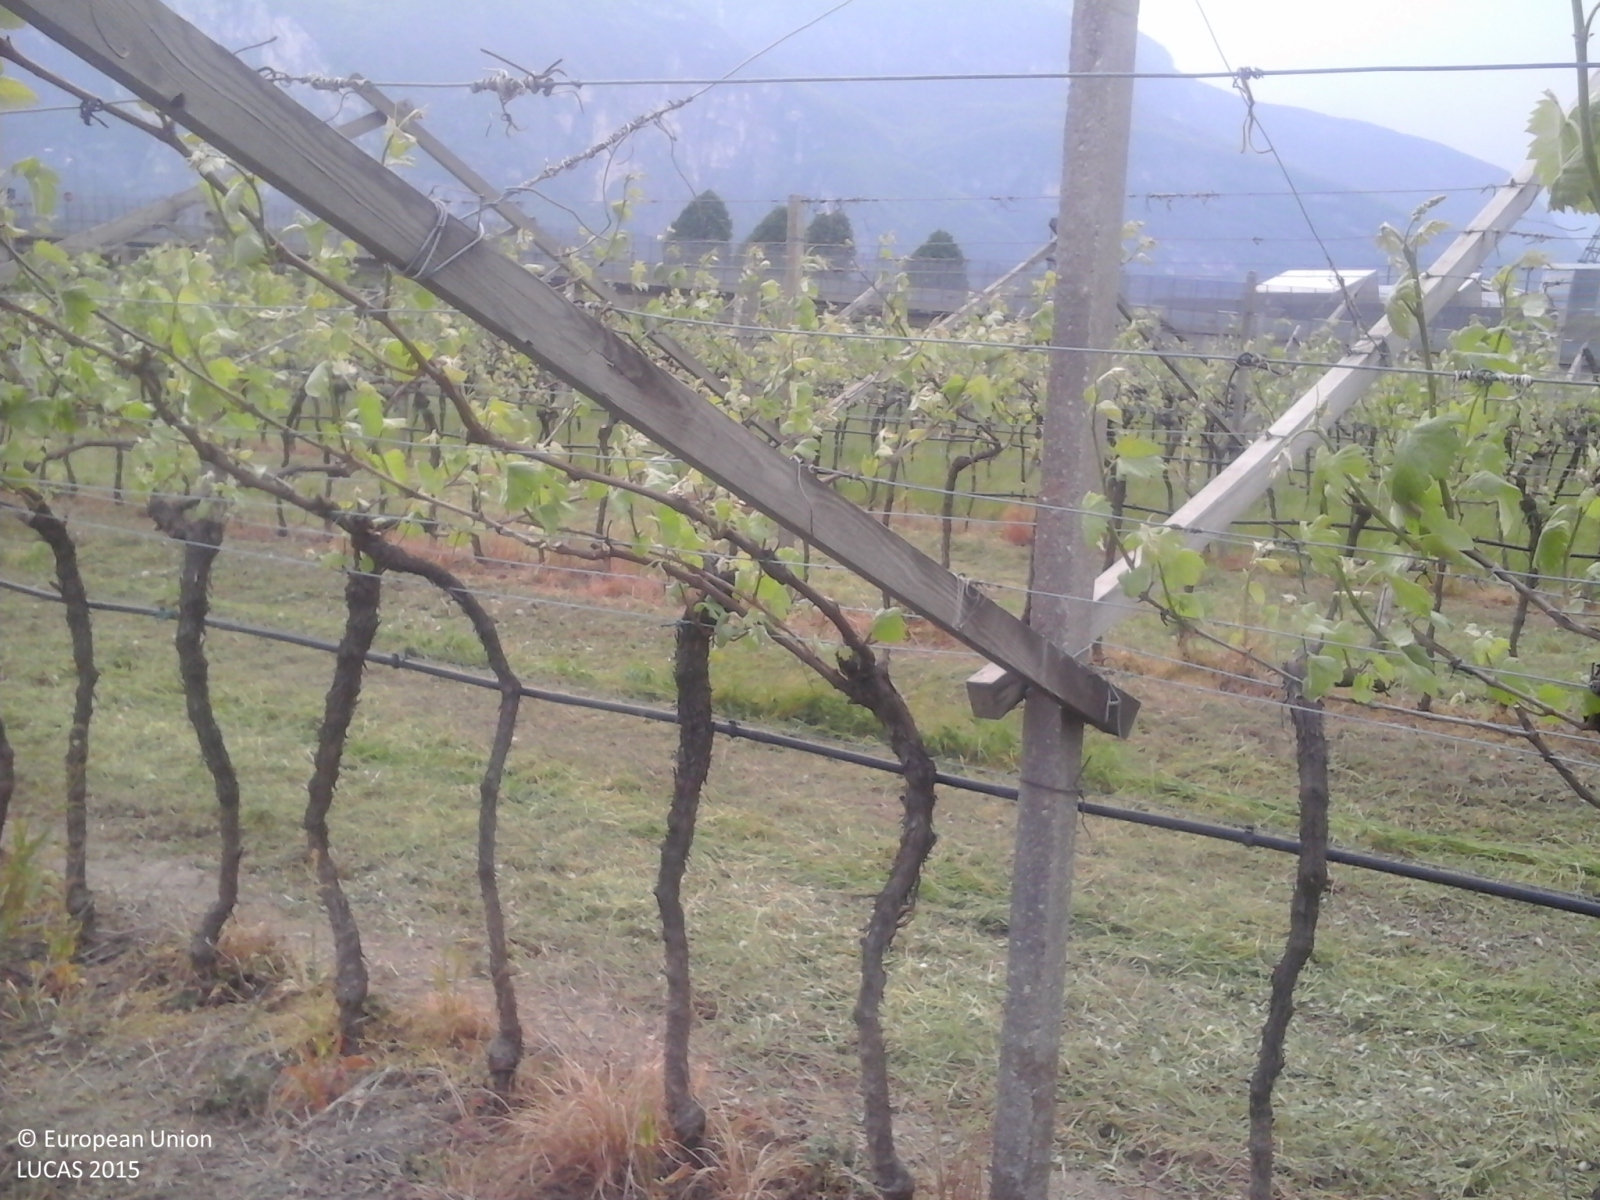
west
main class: Cropland
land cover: Vineyards
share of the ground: 10 - 25 %
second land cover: Grassland without tree/shrub cover
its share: > 75 %
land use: Agriculture (excluding fallow land and kitchen gardens)
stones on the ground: < 10 %
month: April
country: IT
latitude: 46.2012
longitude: 11.1259
